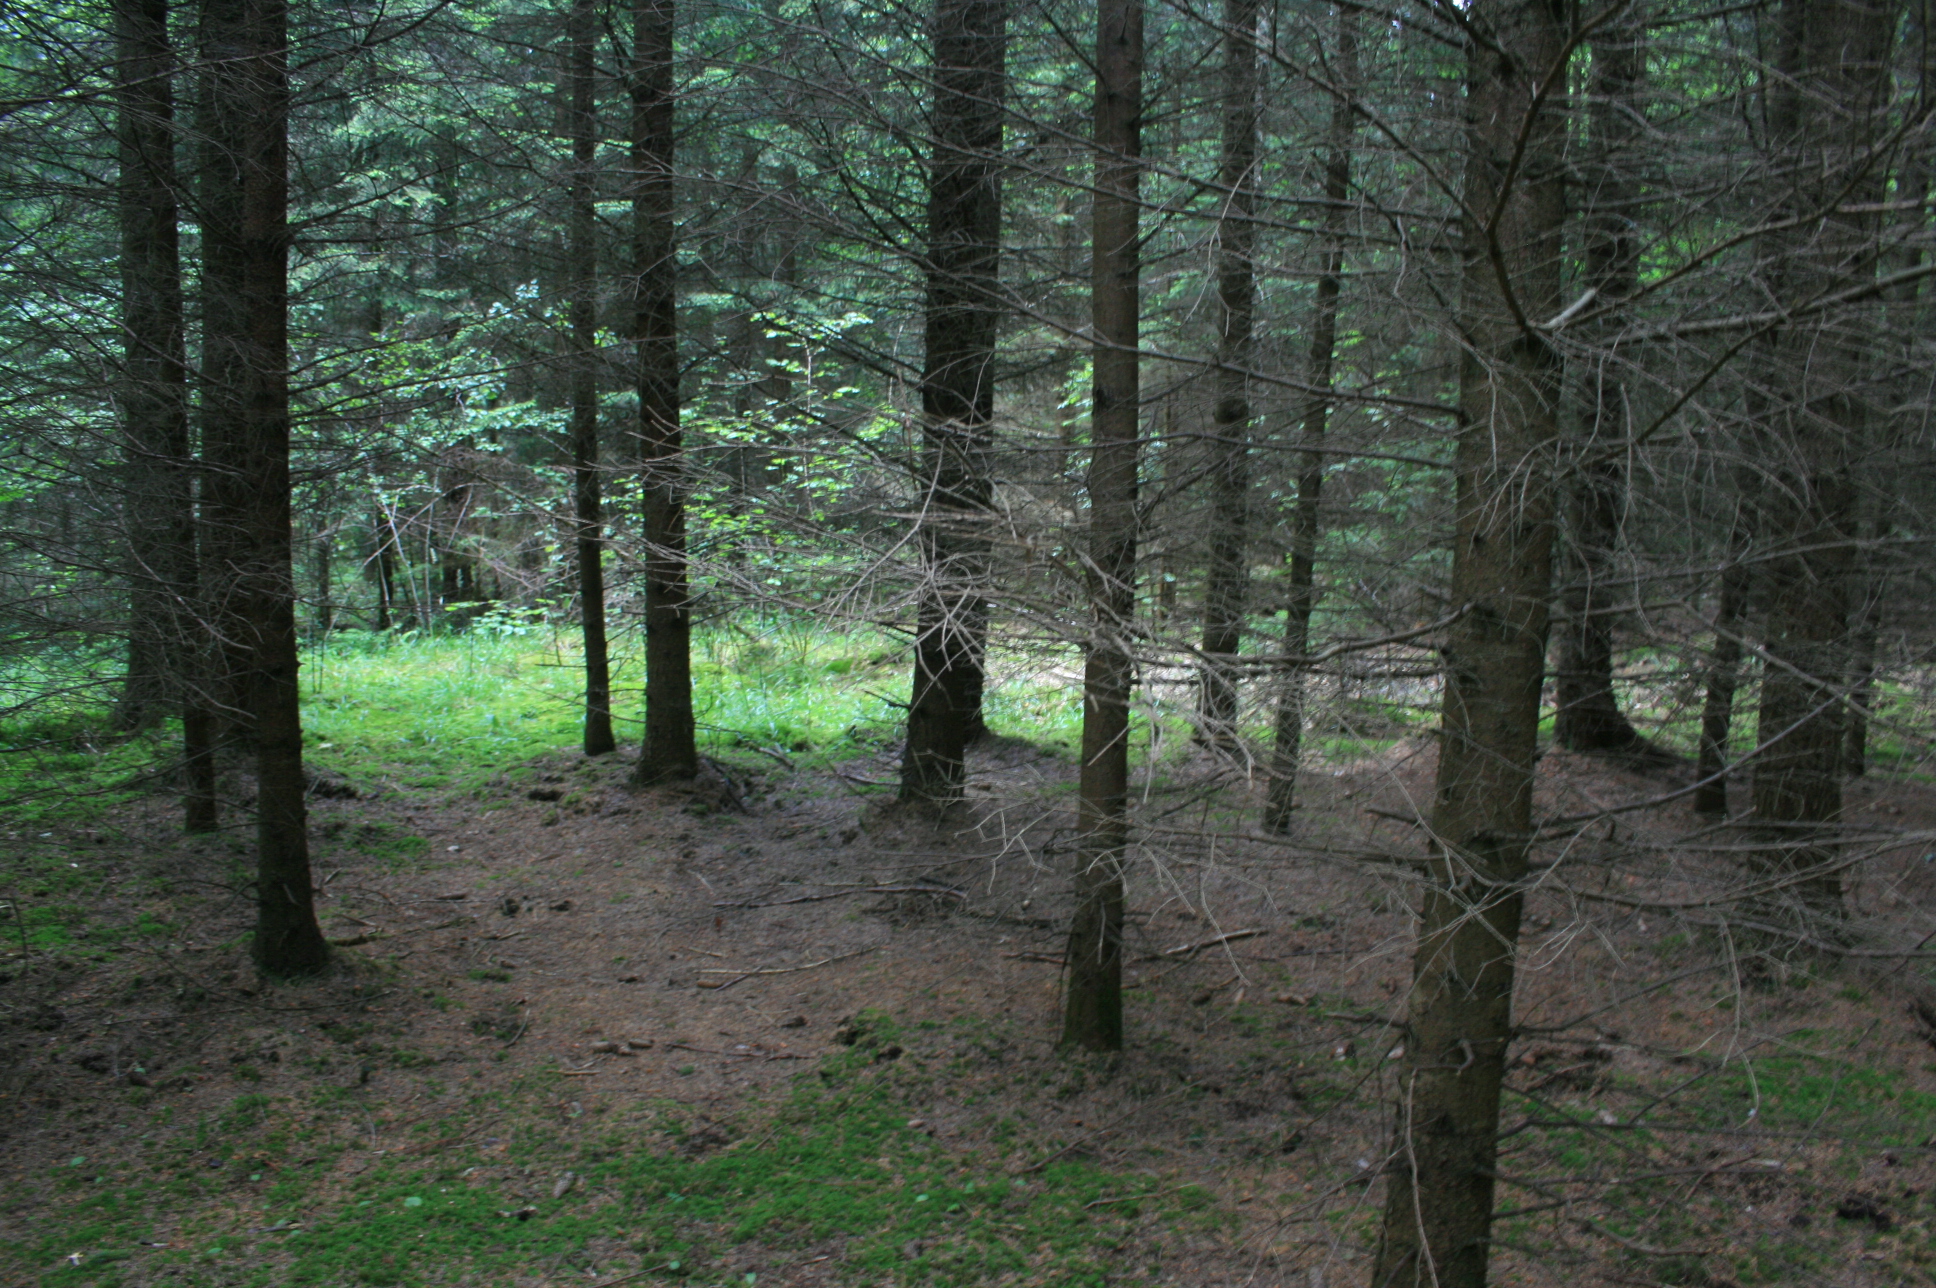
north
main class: Woodland
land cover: Spruce dominated coniferous woodland
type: hemiboreal forest and nemoral coniferous forest and mixed broadleaved-coniferous forest
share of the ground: > 75 %
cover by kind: coniferous forest trees 95 %, lichens and mosses 5 %
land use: Forestry
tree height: > 5 m
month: July
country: LT
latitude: 55.4208
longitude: 21.8209
